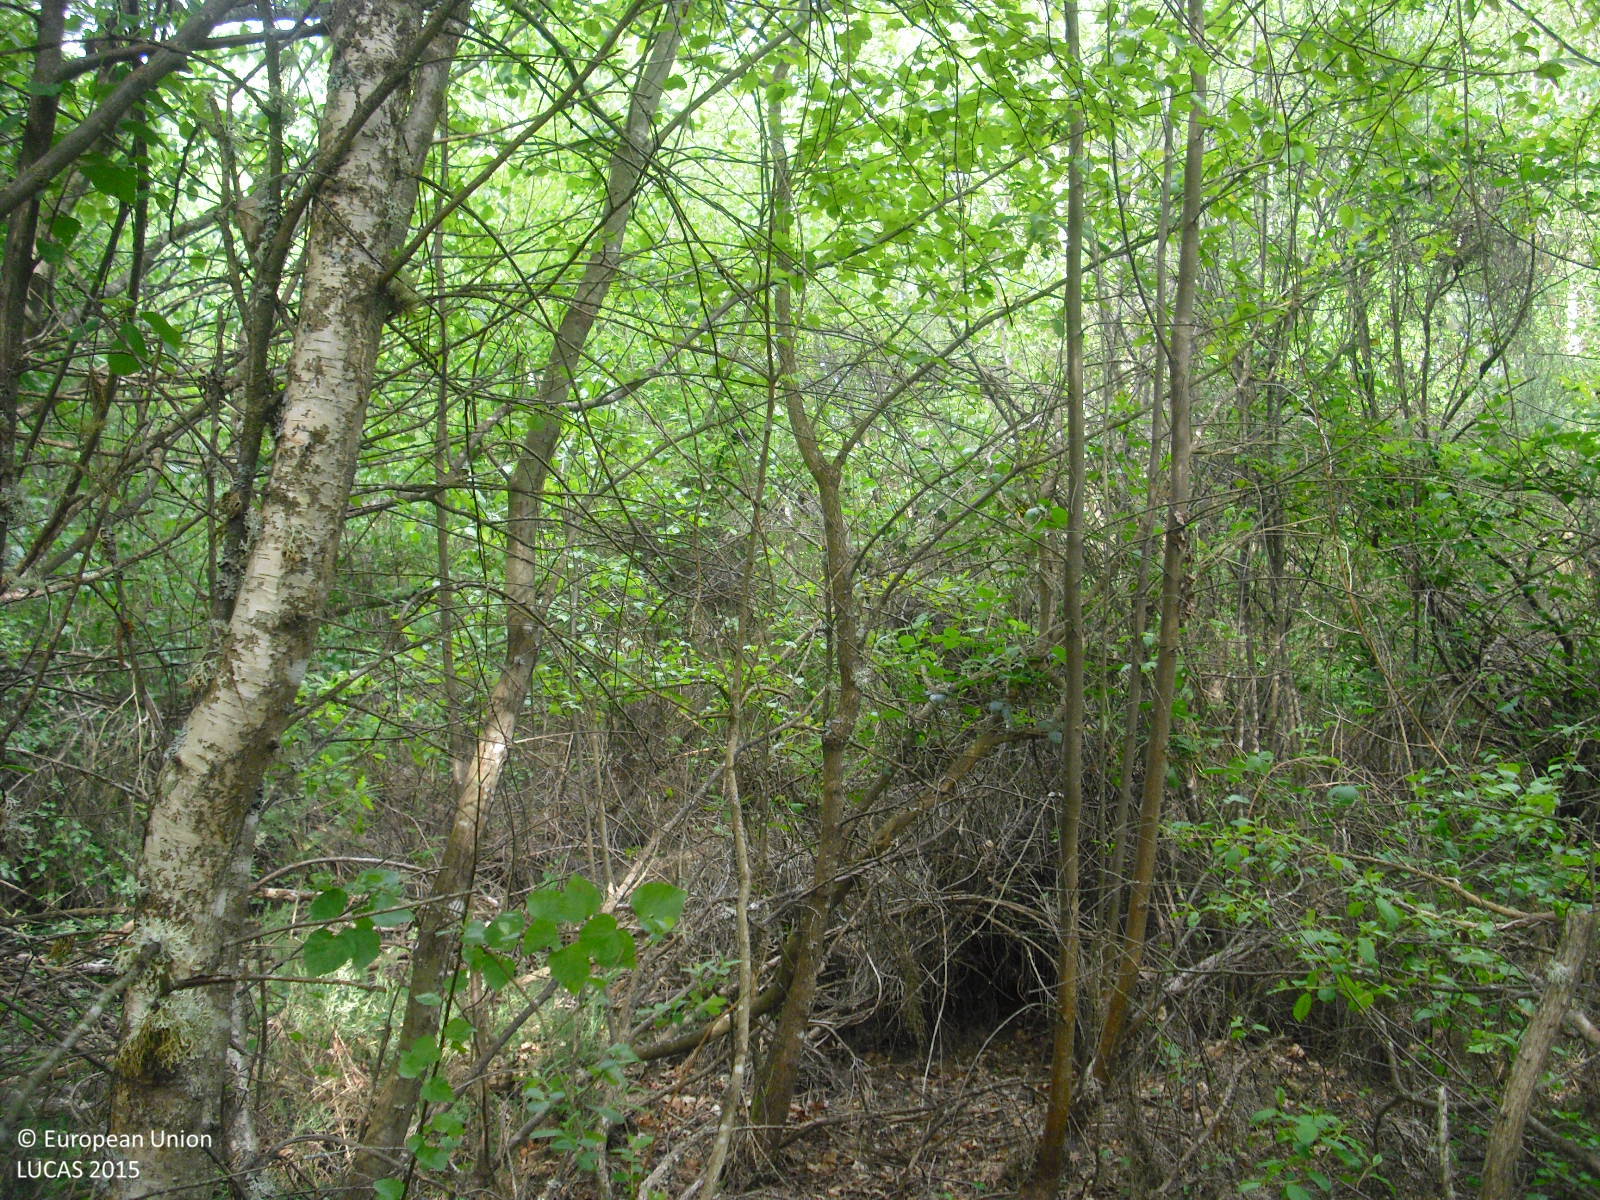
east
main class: Woodland
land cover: Broadleaved woodland
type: acidophilous oak and oak-birch forest
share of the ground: > 75 %
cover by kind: broadleaved forest trees 80 %, shrubs 20 %
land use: Semi-natural and natural areas not in use
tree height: > 5 m
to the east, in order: Broadleaved woodland; Shrubland with sparse tree cover; Broadleaved woodland; Ditches and canals; Shruby margins; Tracks; Grass margins; Ditches and canals; Shruby margins; Spontaneously vegetated surfaces; Shruby margins; Ditches and canals; Grass margins; Common wheat
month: May
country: ES
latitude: 42.1717
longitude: -7.6831
